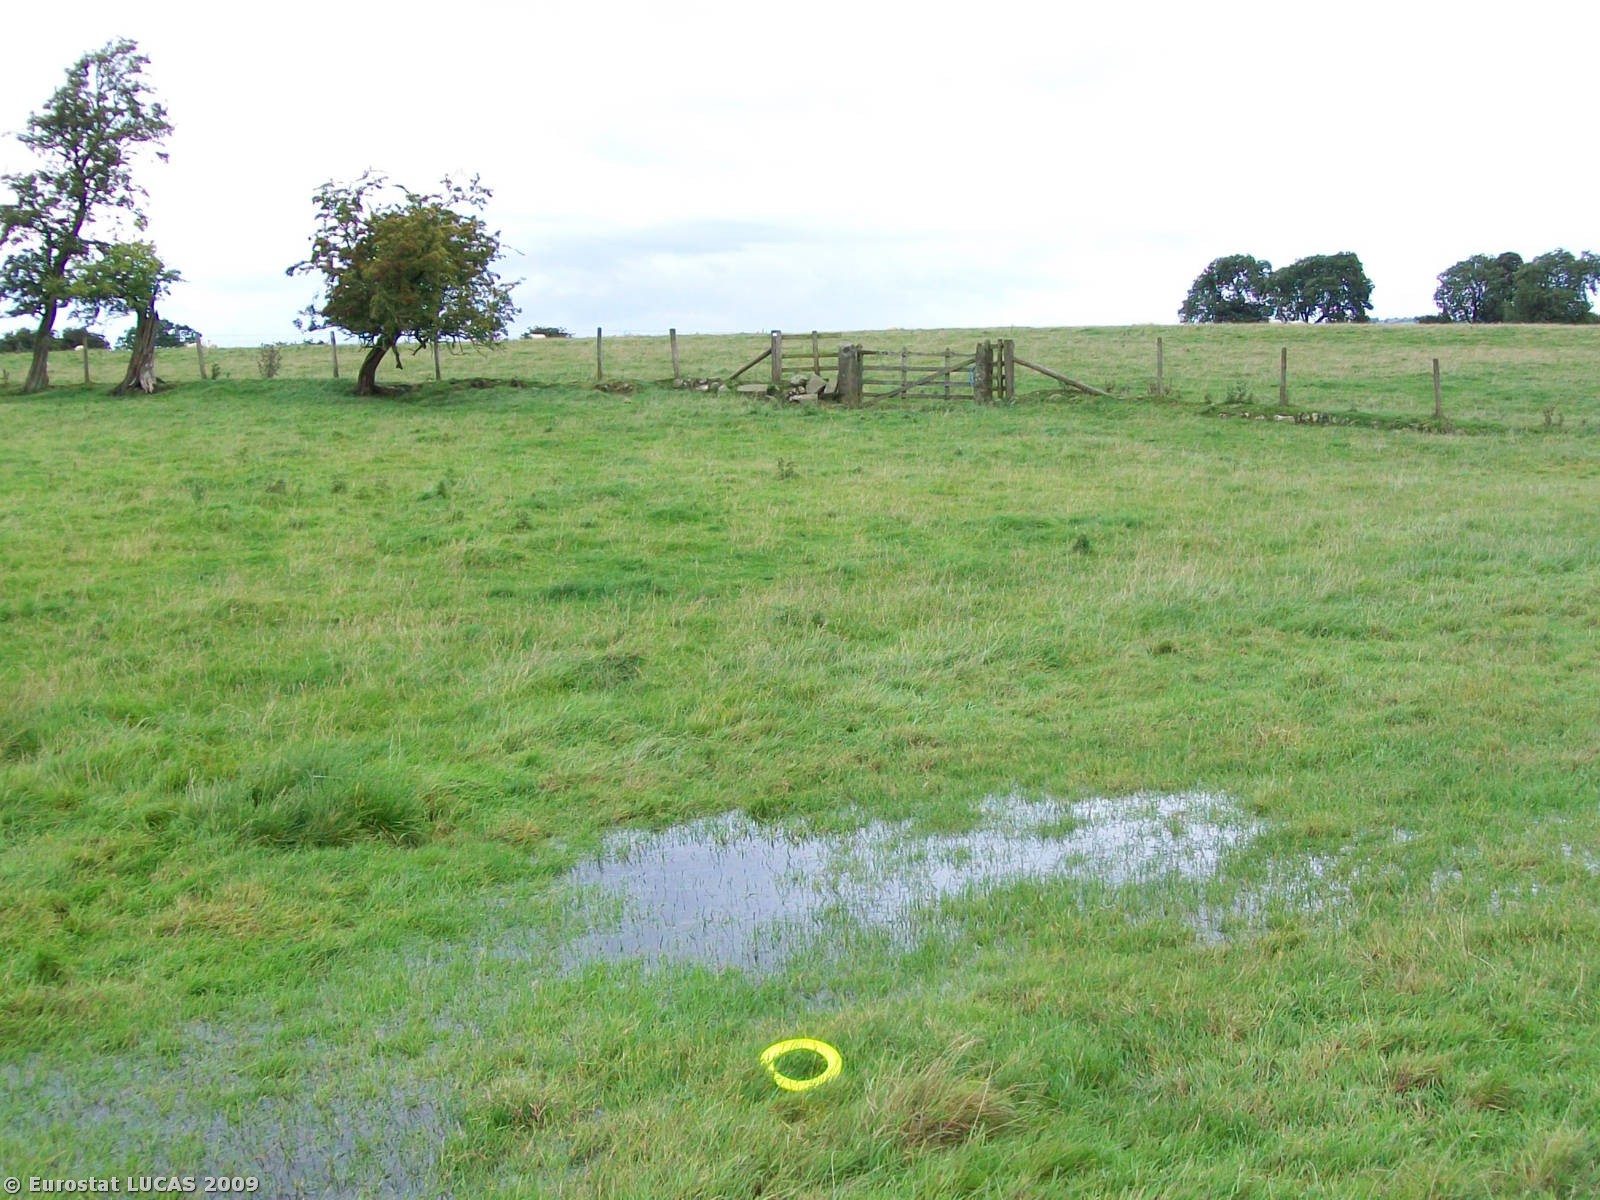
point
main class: Grassland
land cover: Grassland without tree/shrub cover
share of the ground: > 75 %
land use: Agriculture (excluding fallow land and kitchen gardens)
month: September
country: GB
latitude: 55.0228
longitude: -1.9891
